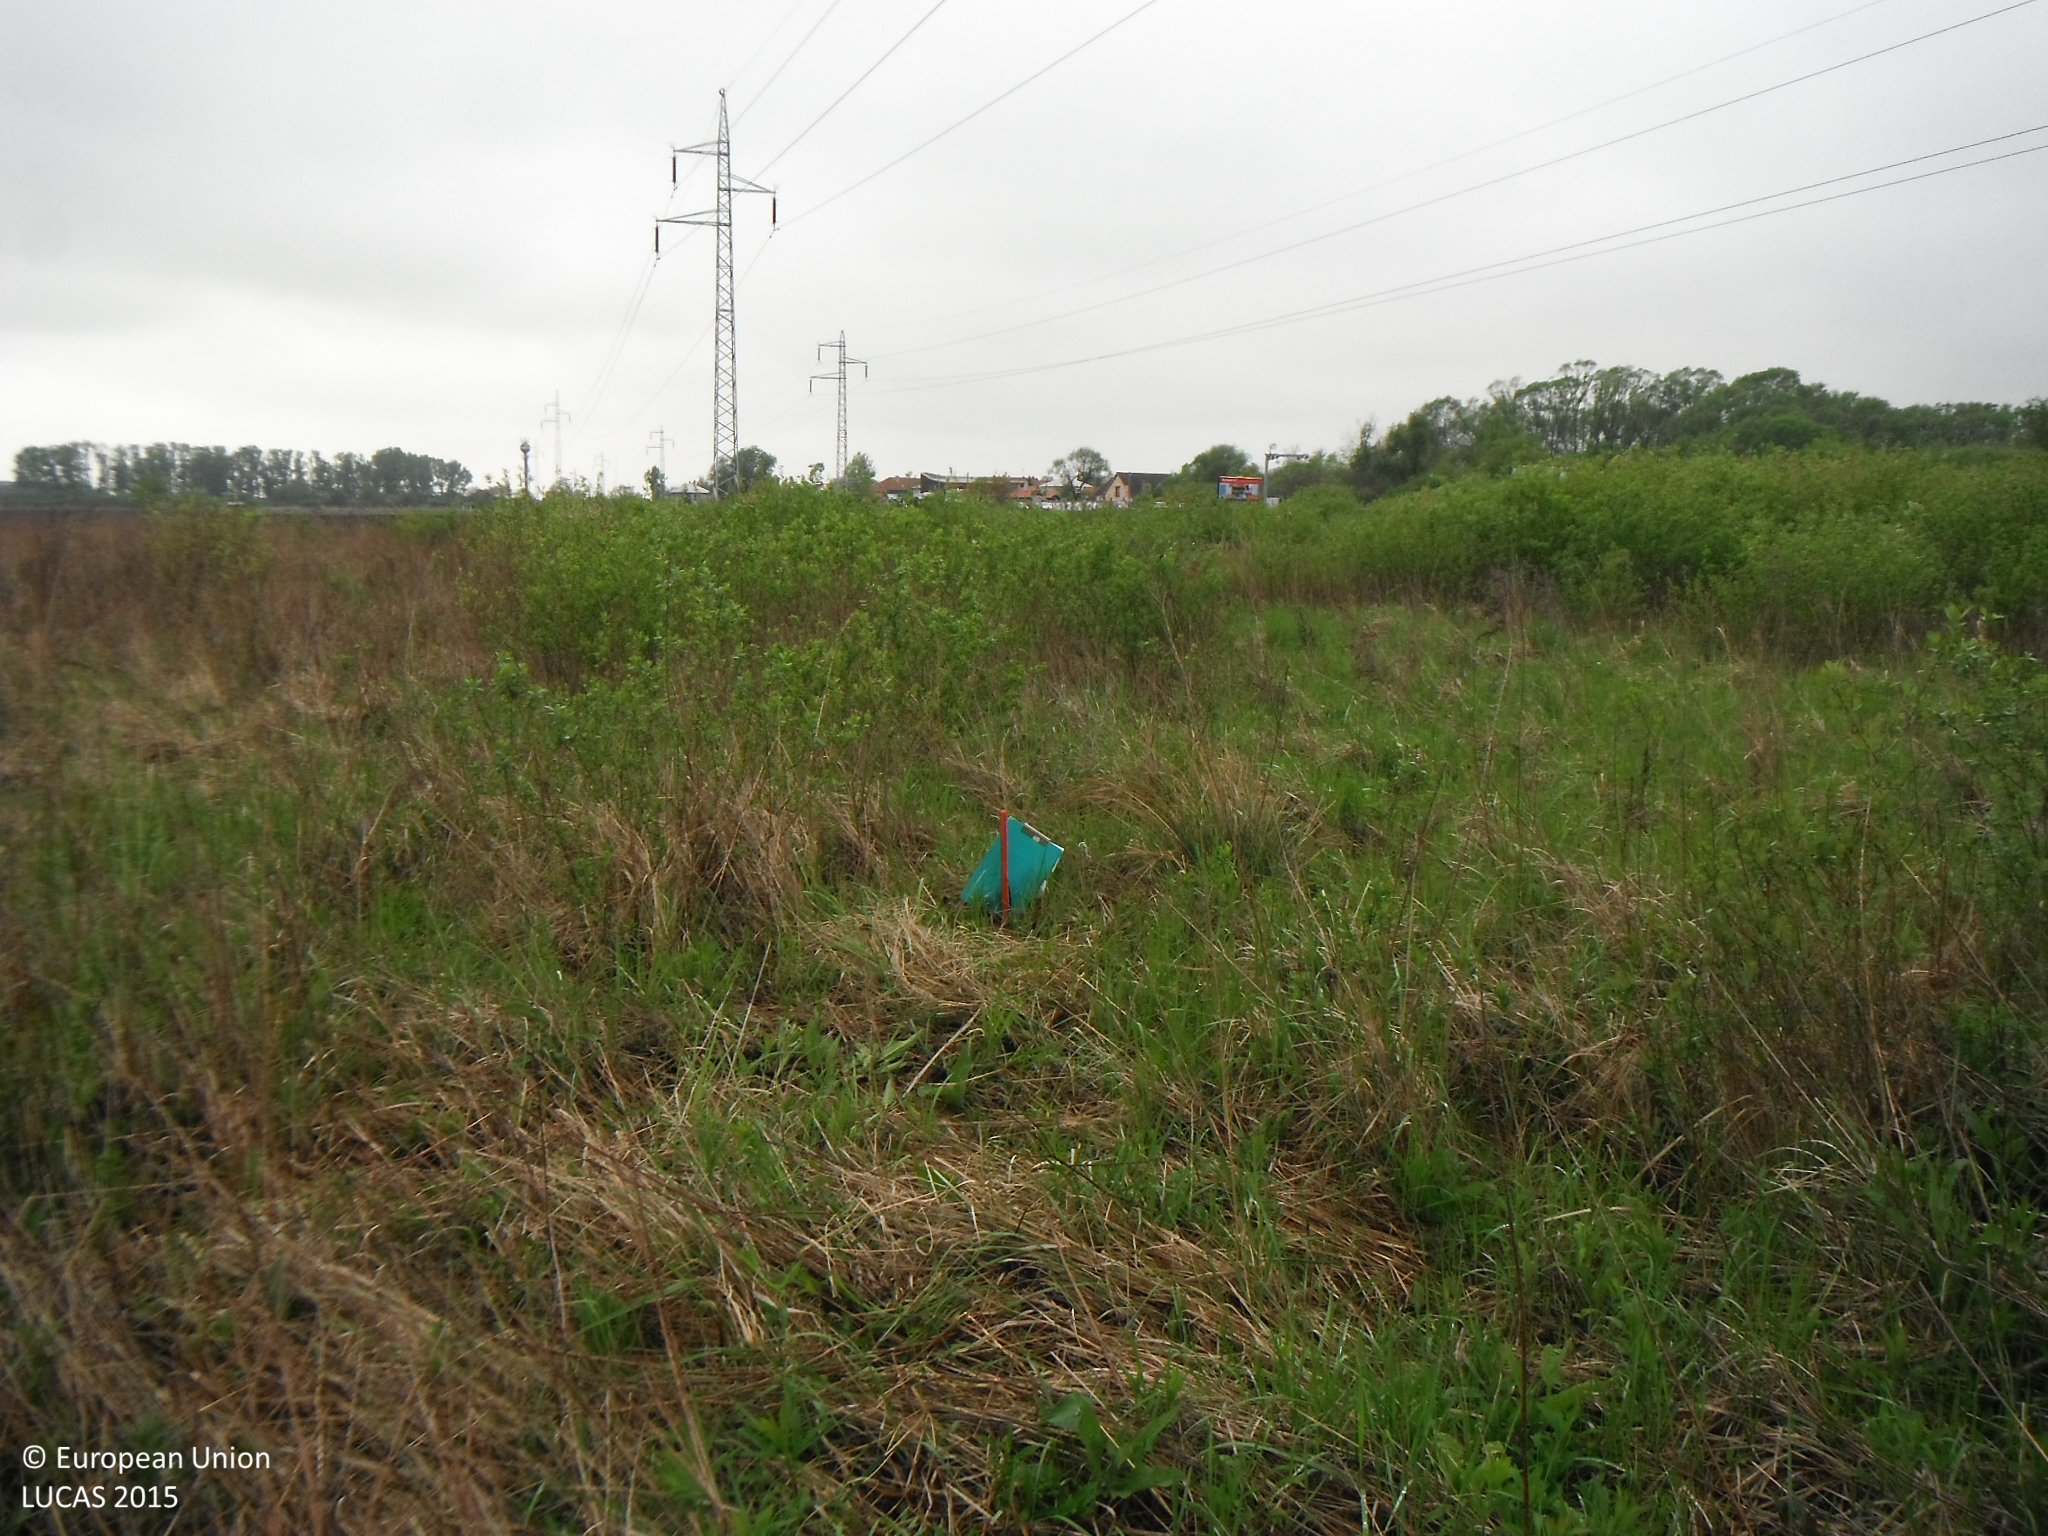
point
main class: Shrubland
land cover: Shrubland without tree cover
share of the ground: > 75 %
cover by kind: herbaceous plants 75 %, shrubs 25 %
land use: Abandoned areas
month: May
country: SK
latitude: 48.6606
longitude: 21.2725
